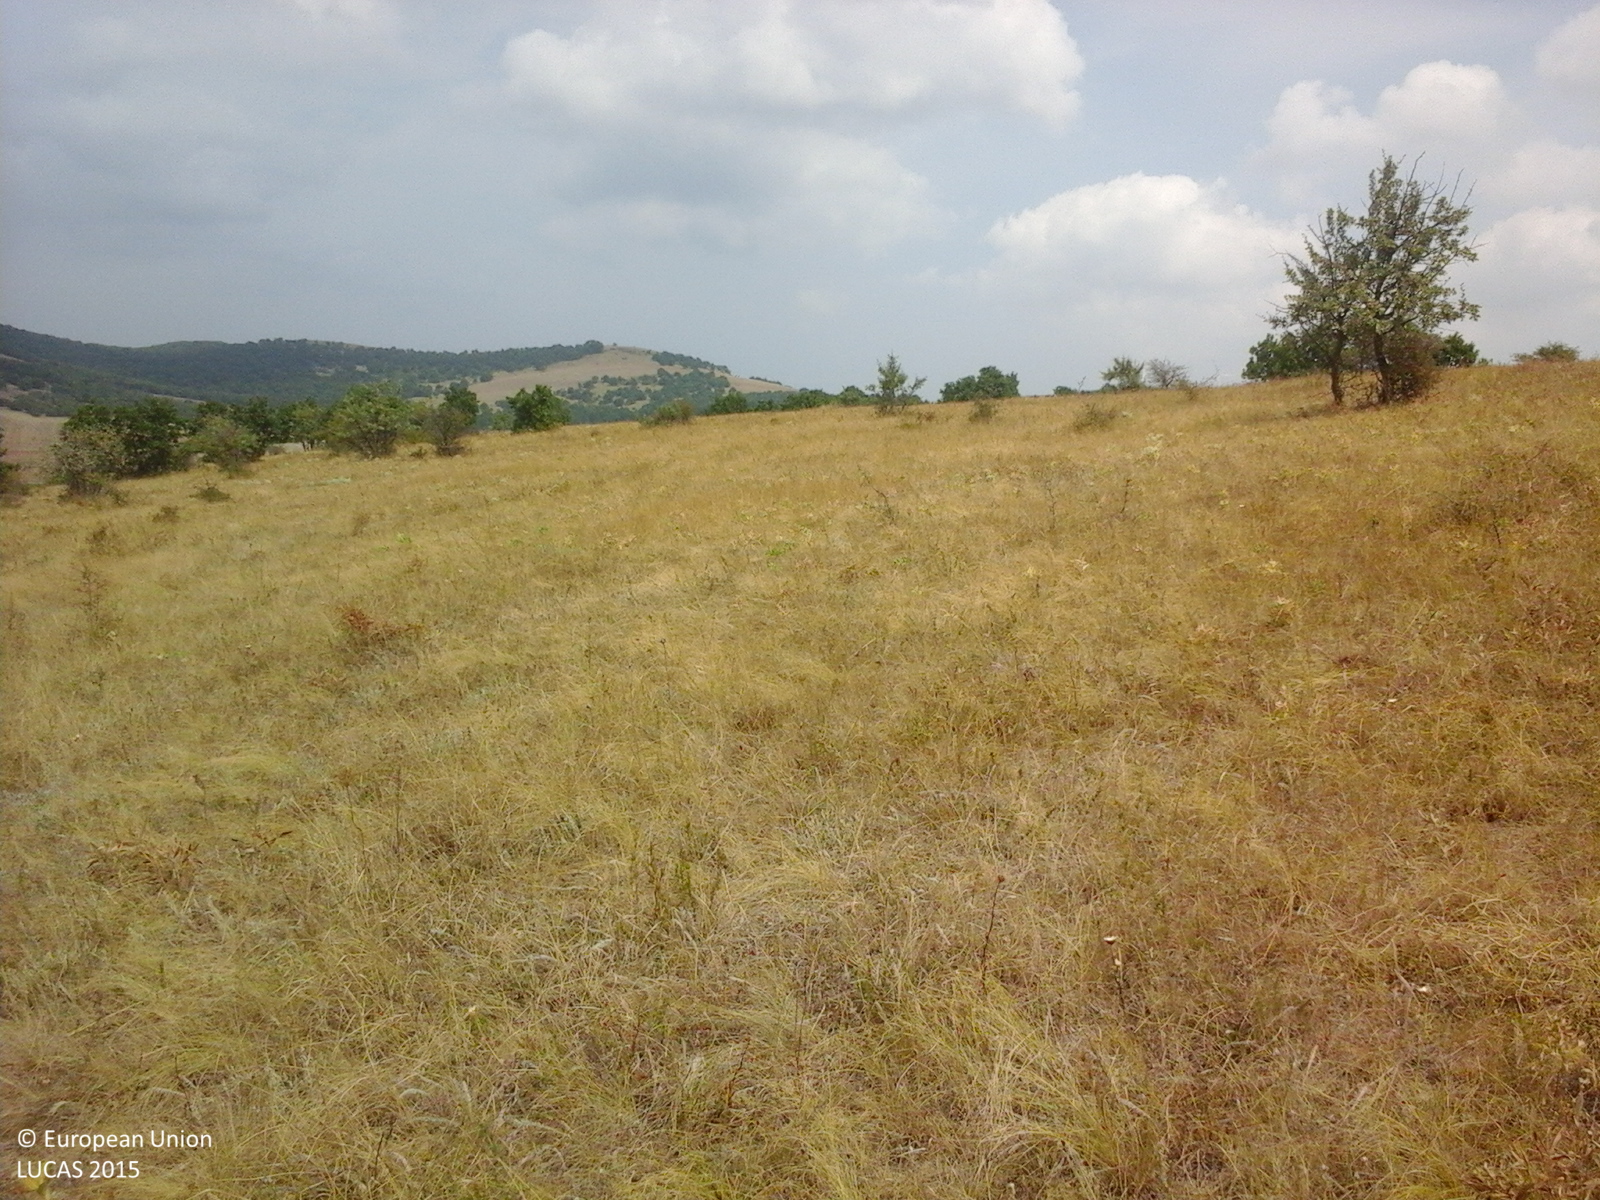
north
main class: Grassland
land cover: Grassland with sparse tree/shrub cover
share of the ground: > 75 %
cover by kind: herbaceous plants 85 %, shrubs 10 %, broadleaved forest trees 5 %
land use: Agriculture (excluding fallow land and kitchen gardens)
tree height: < 5 m
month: July
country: RO
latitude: 45.0594
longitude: 28.5576
